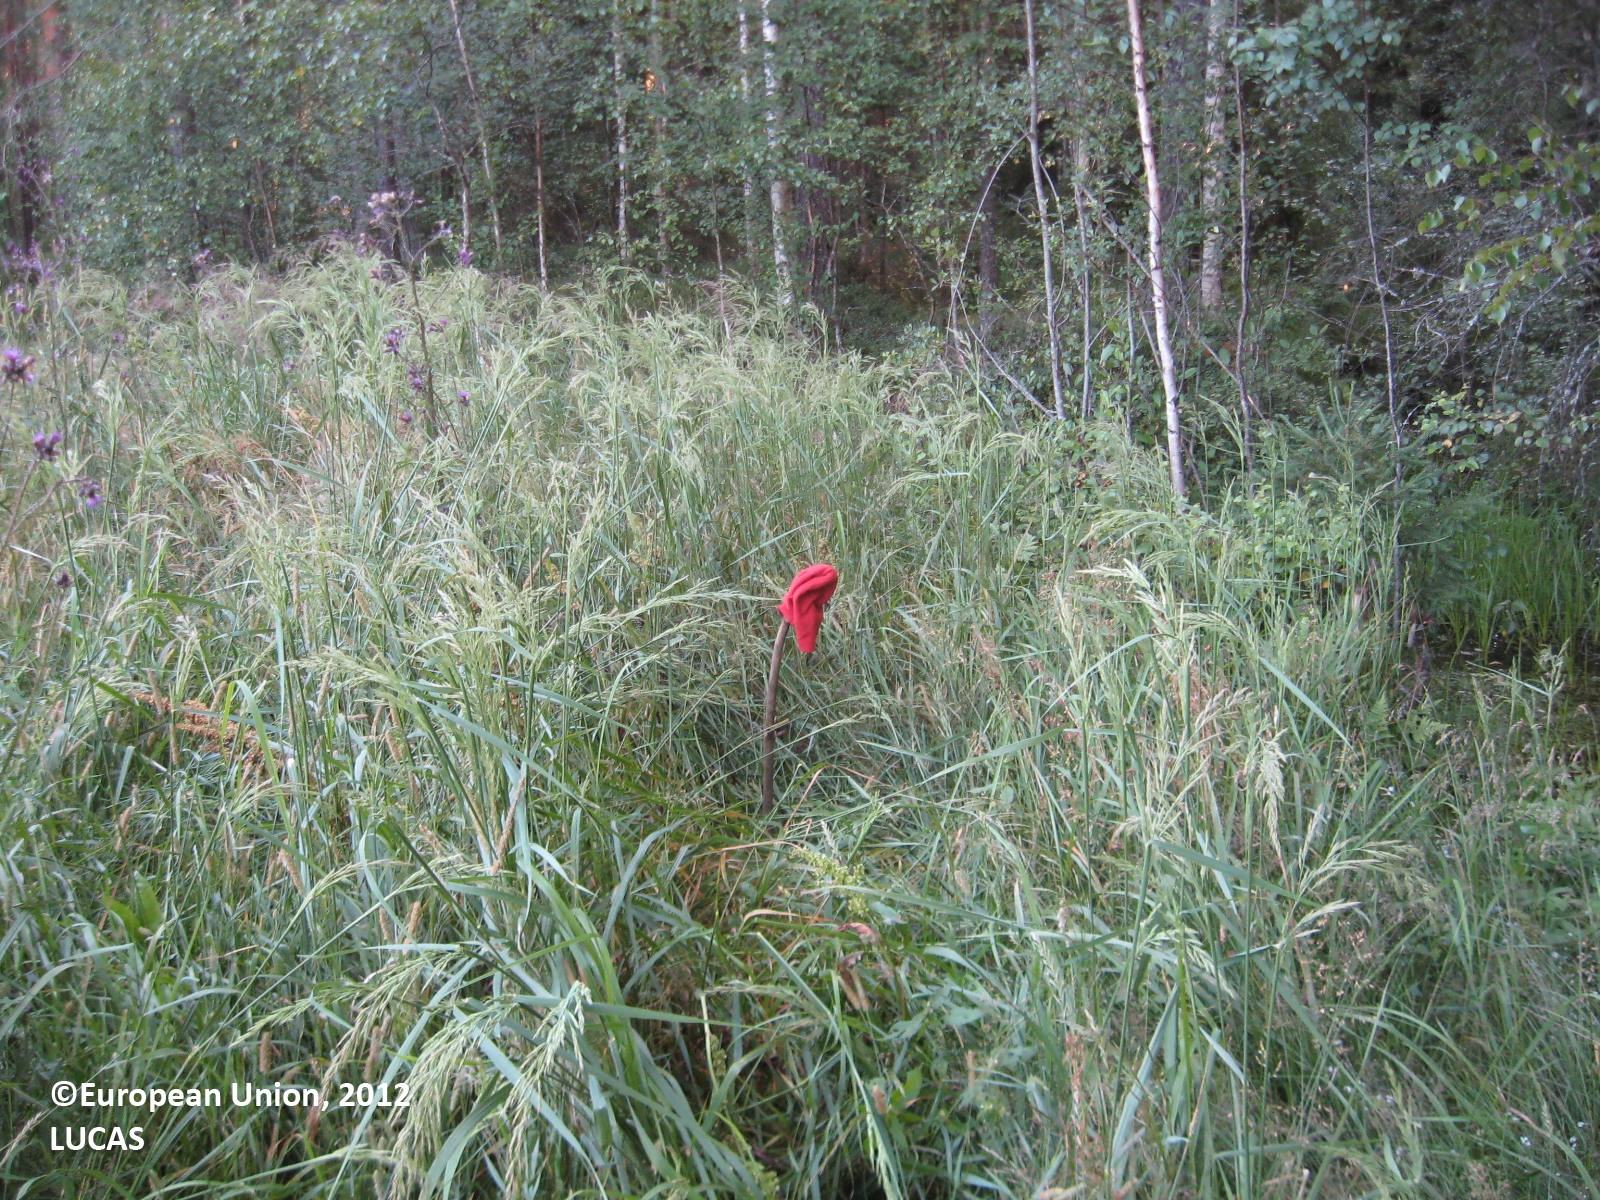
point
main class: Grassland
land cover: Spontaneously vegetated surfaces
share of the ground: > 75 %
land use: Abandoned areas
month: July
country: FI
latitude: 61.8613
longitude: 22.1639
